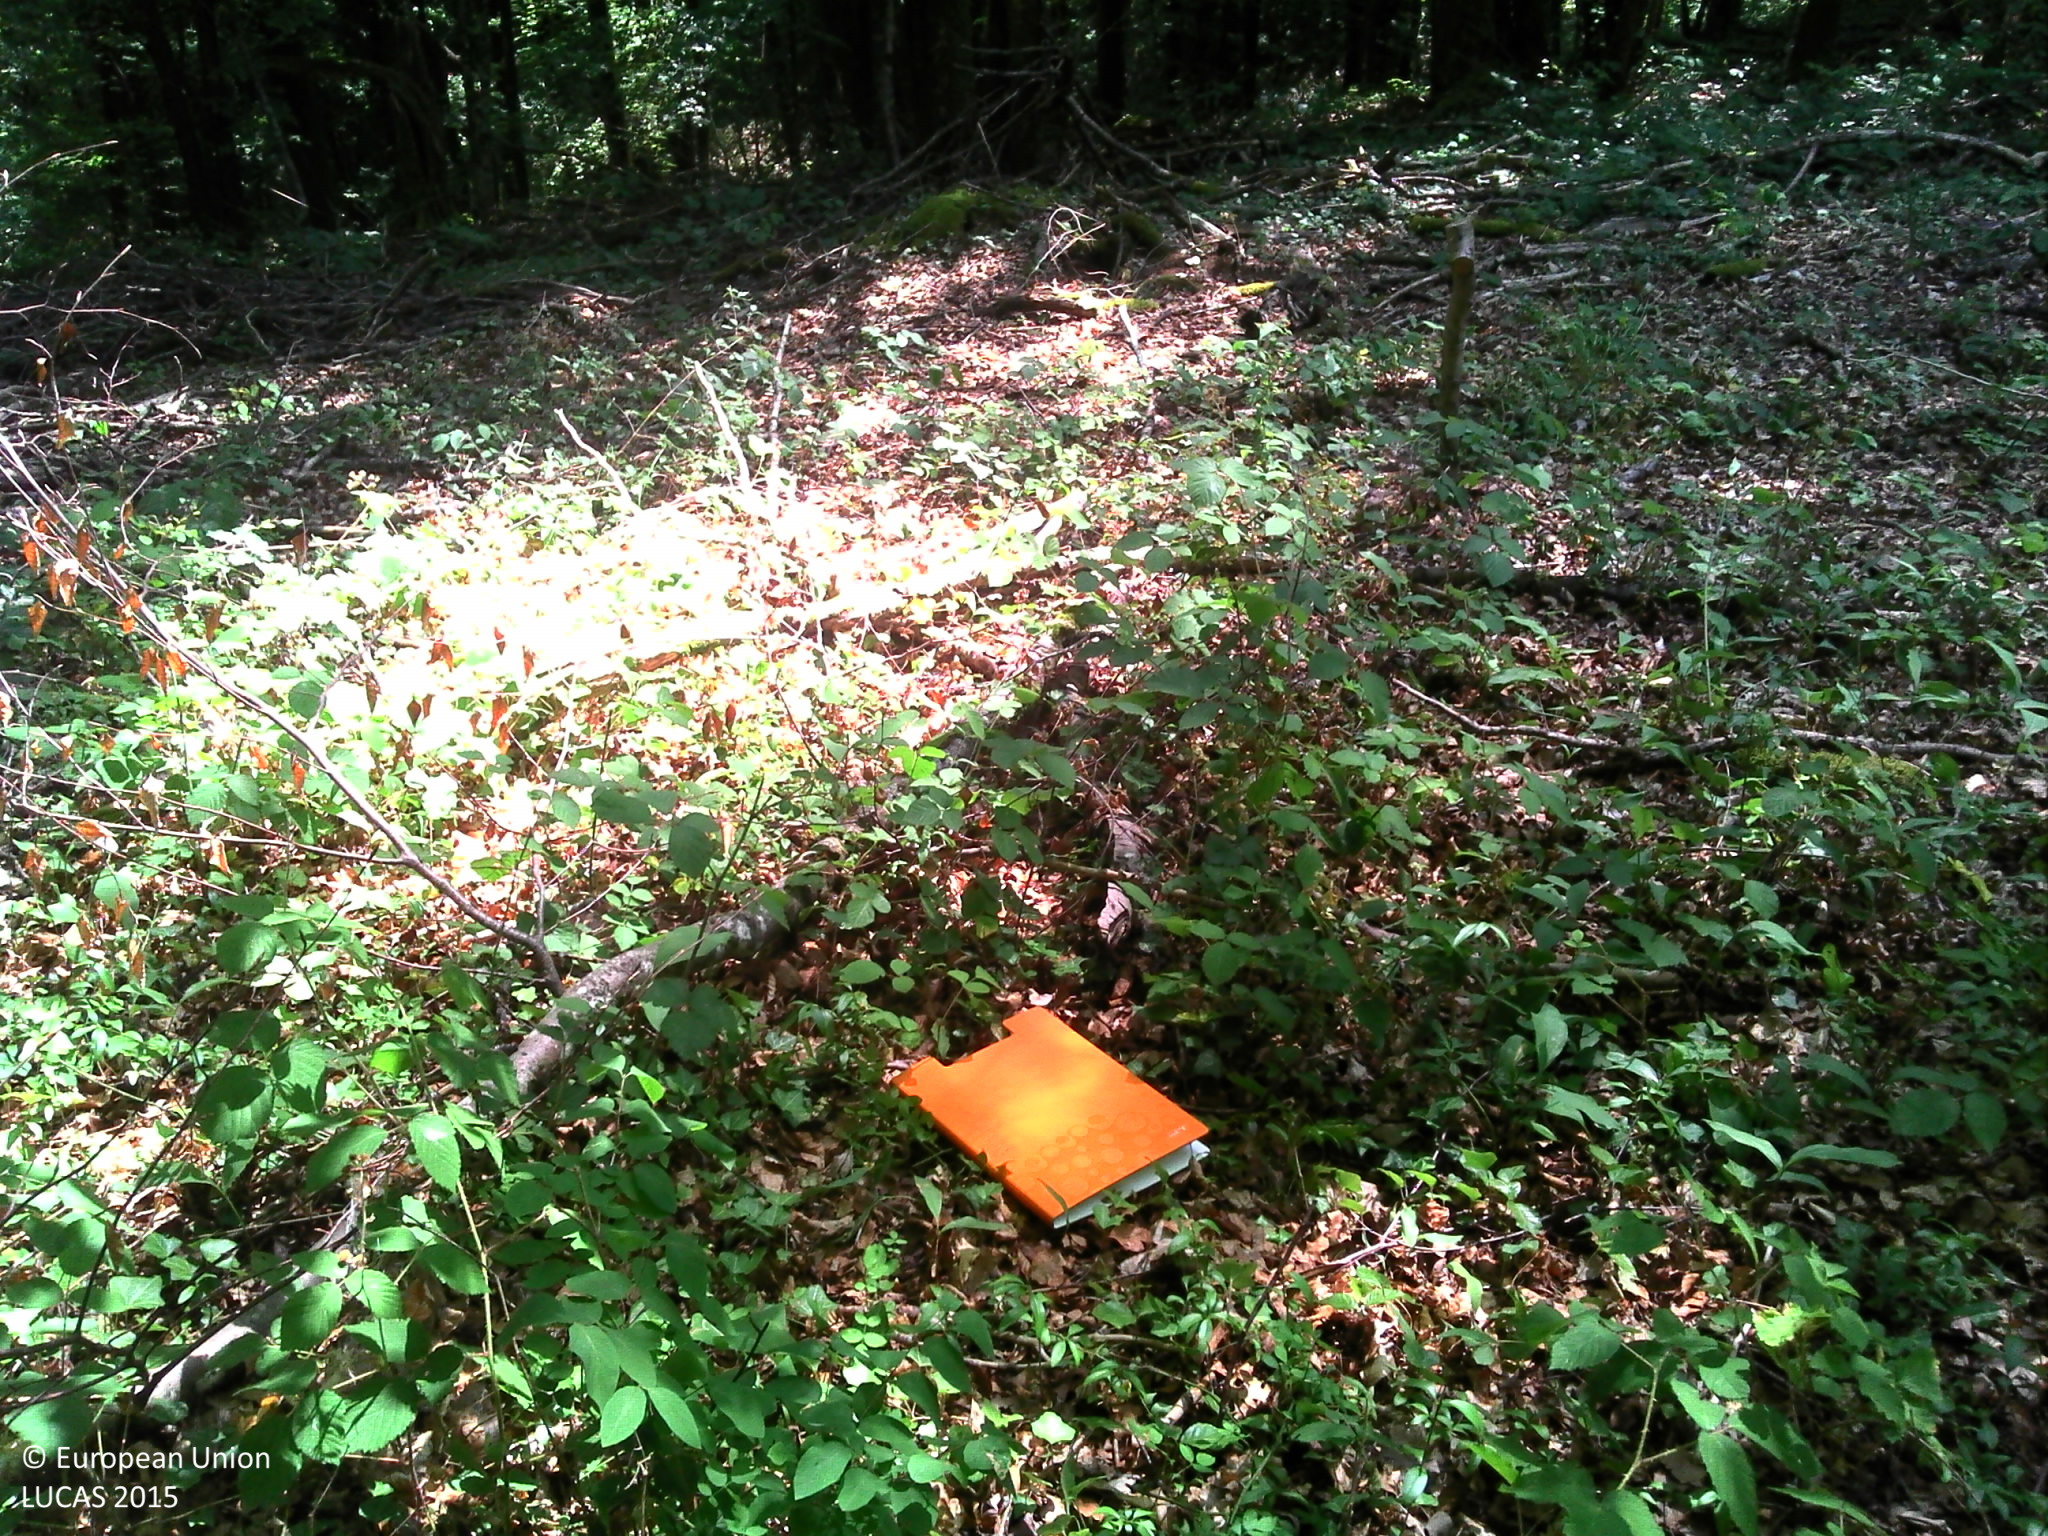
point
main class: Woodland
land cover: Broadleaved woodland
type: beech forest
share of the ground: > 75 %
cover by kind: broadleaved forest trees 85 %, lichens and mosses 10 %, herbaceous plants 5 %
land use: Forestry
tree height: > 5 m
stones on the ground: < 10 %
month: July
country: FR
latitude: 48.1214
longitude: 4.8534
